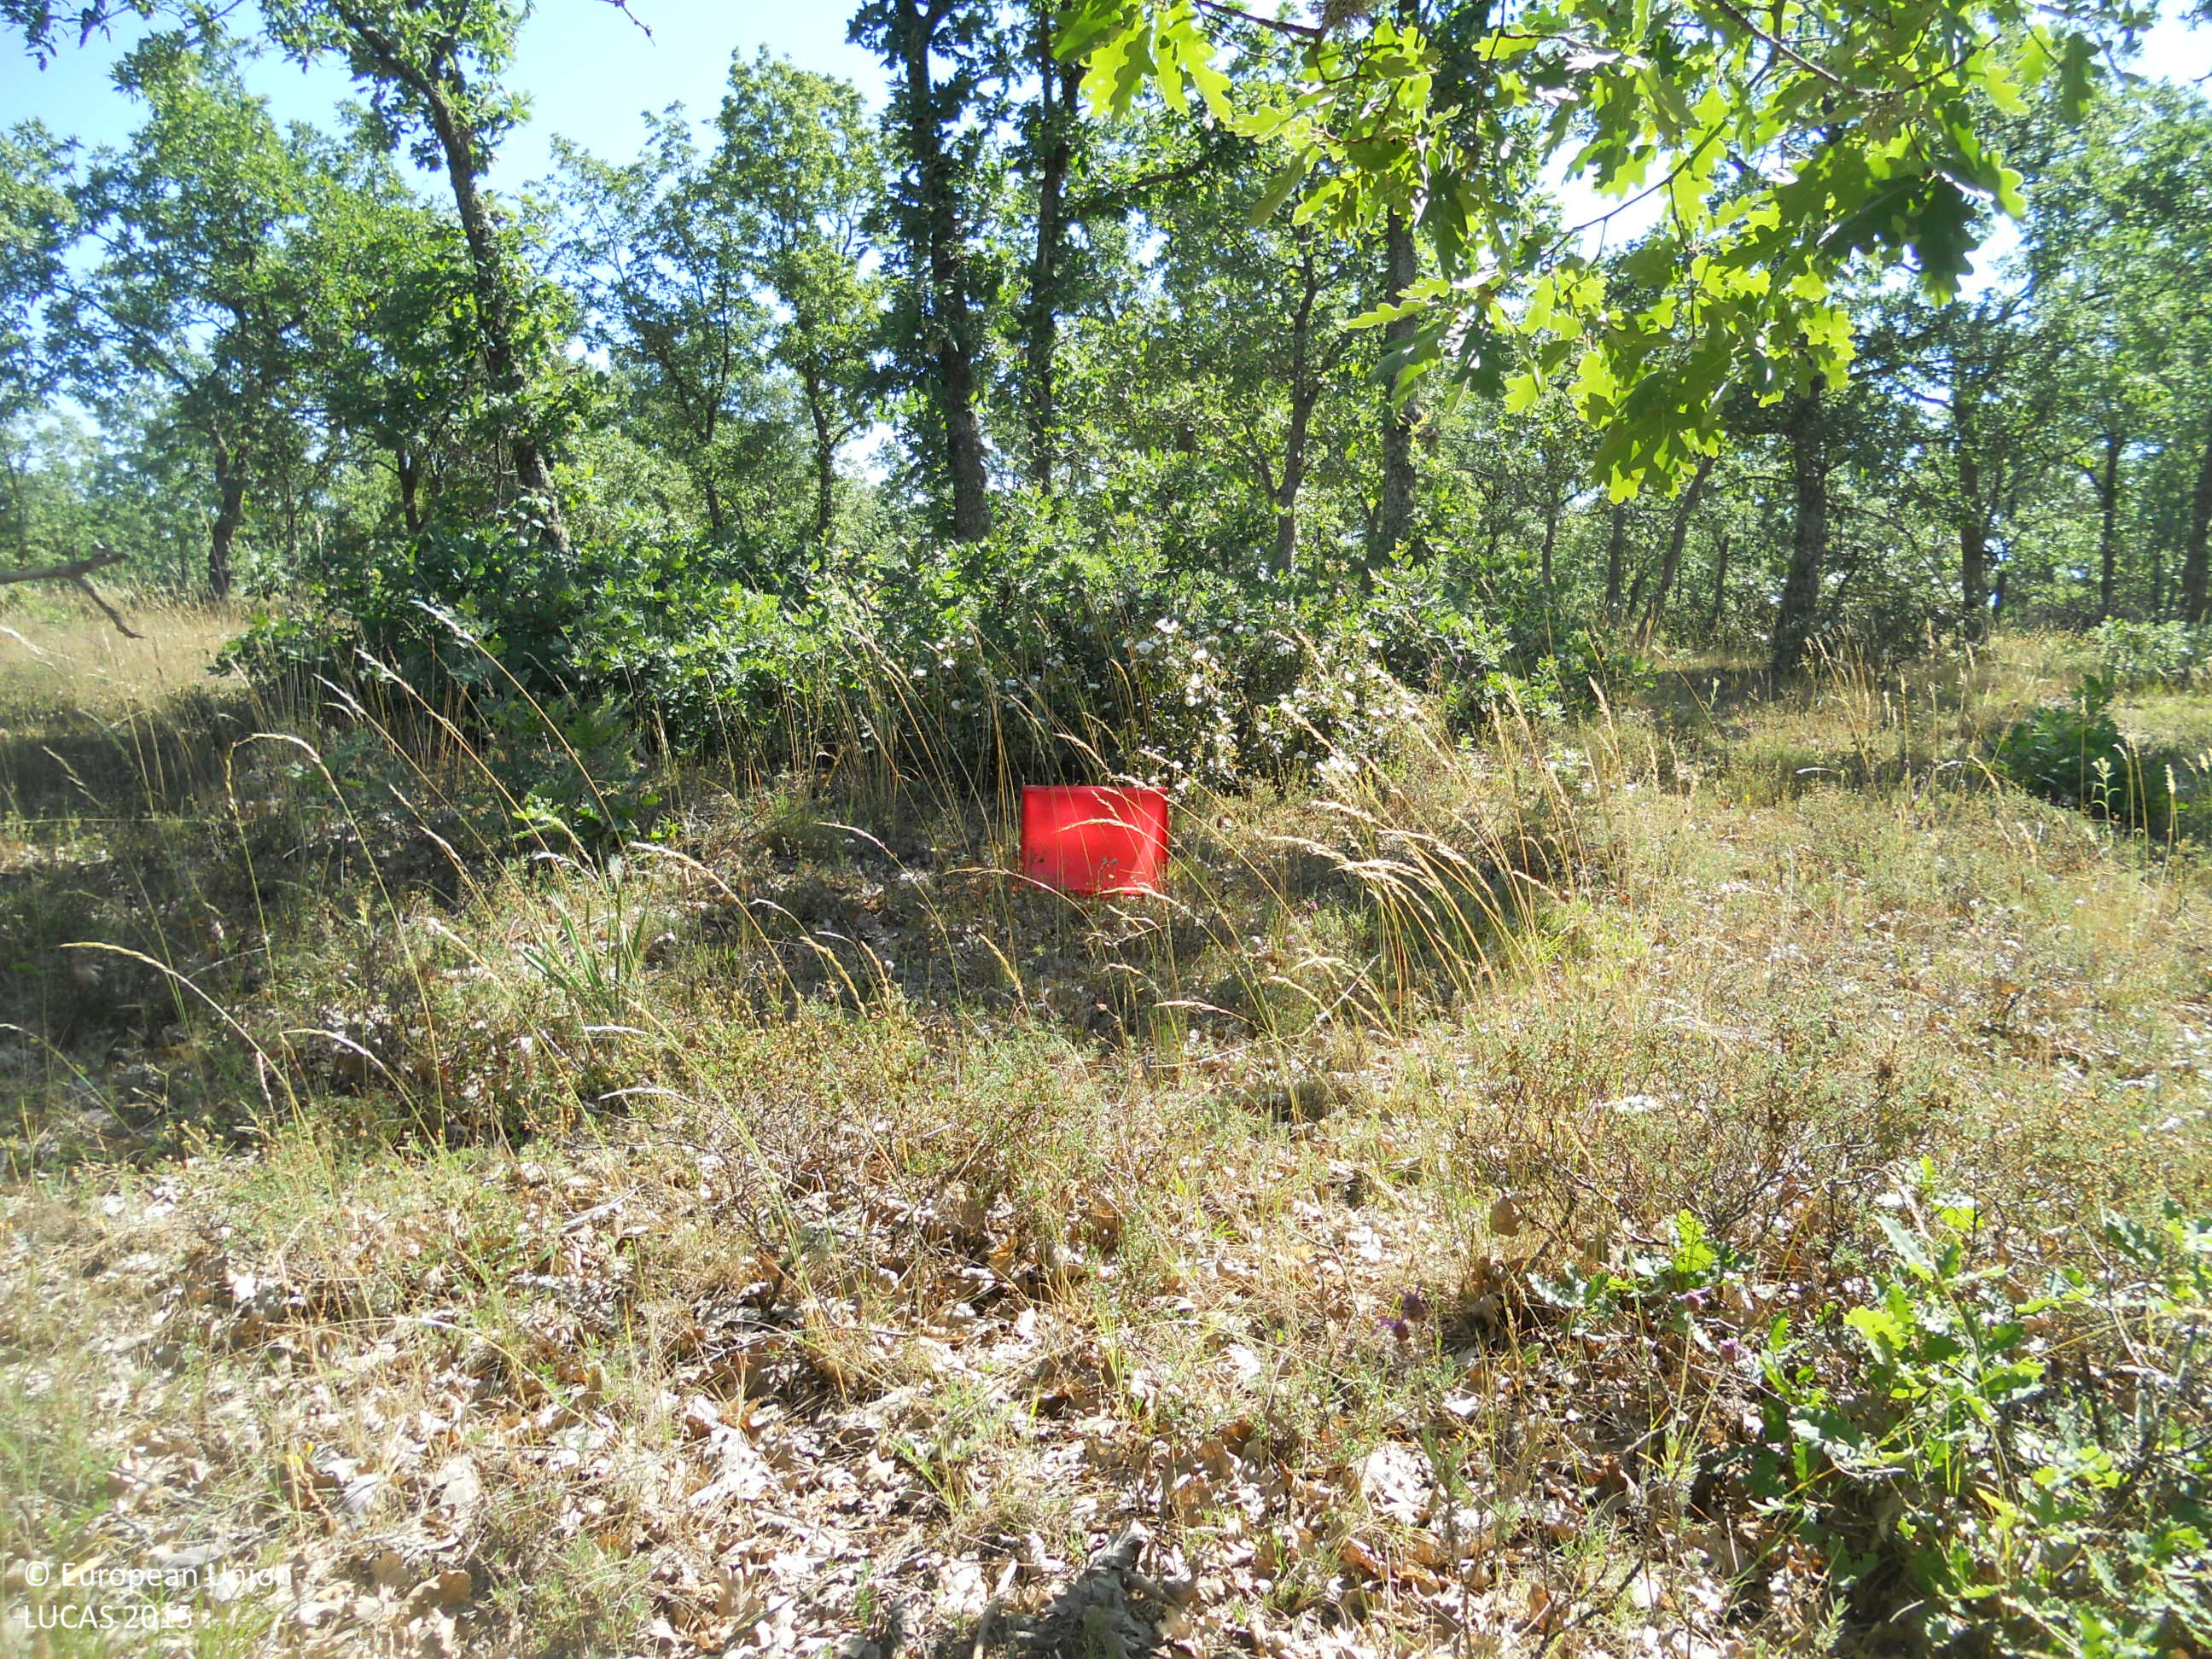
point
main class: Woodland
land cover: Broadleaved woodland
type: thermophilous deciduous forest
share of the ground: 50 - 75 %
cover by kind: herbaceous plants 55 %, broadleaved forest trees 45 %
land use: Forestry
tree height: > 5 m
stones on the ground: > 50 %
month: June
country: ES
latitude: 42.3898
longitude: -4.8886
